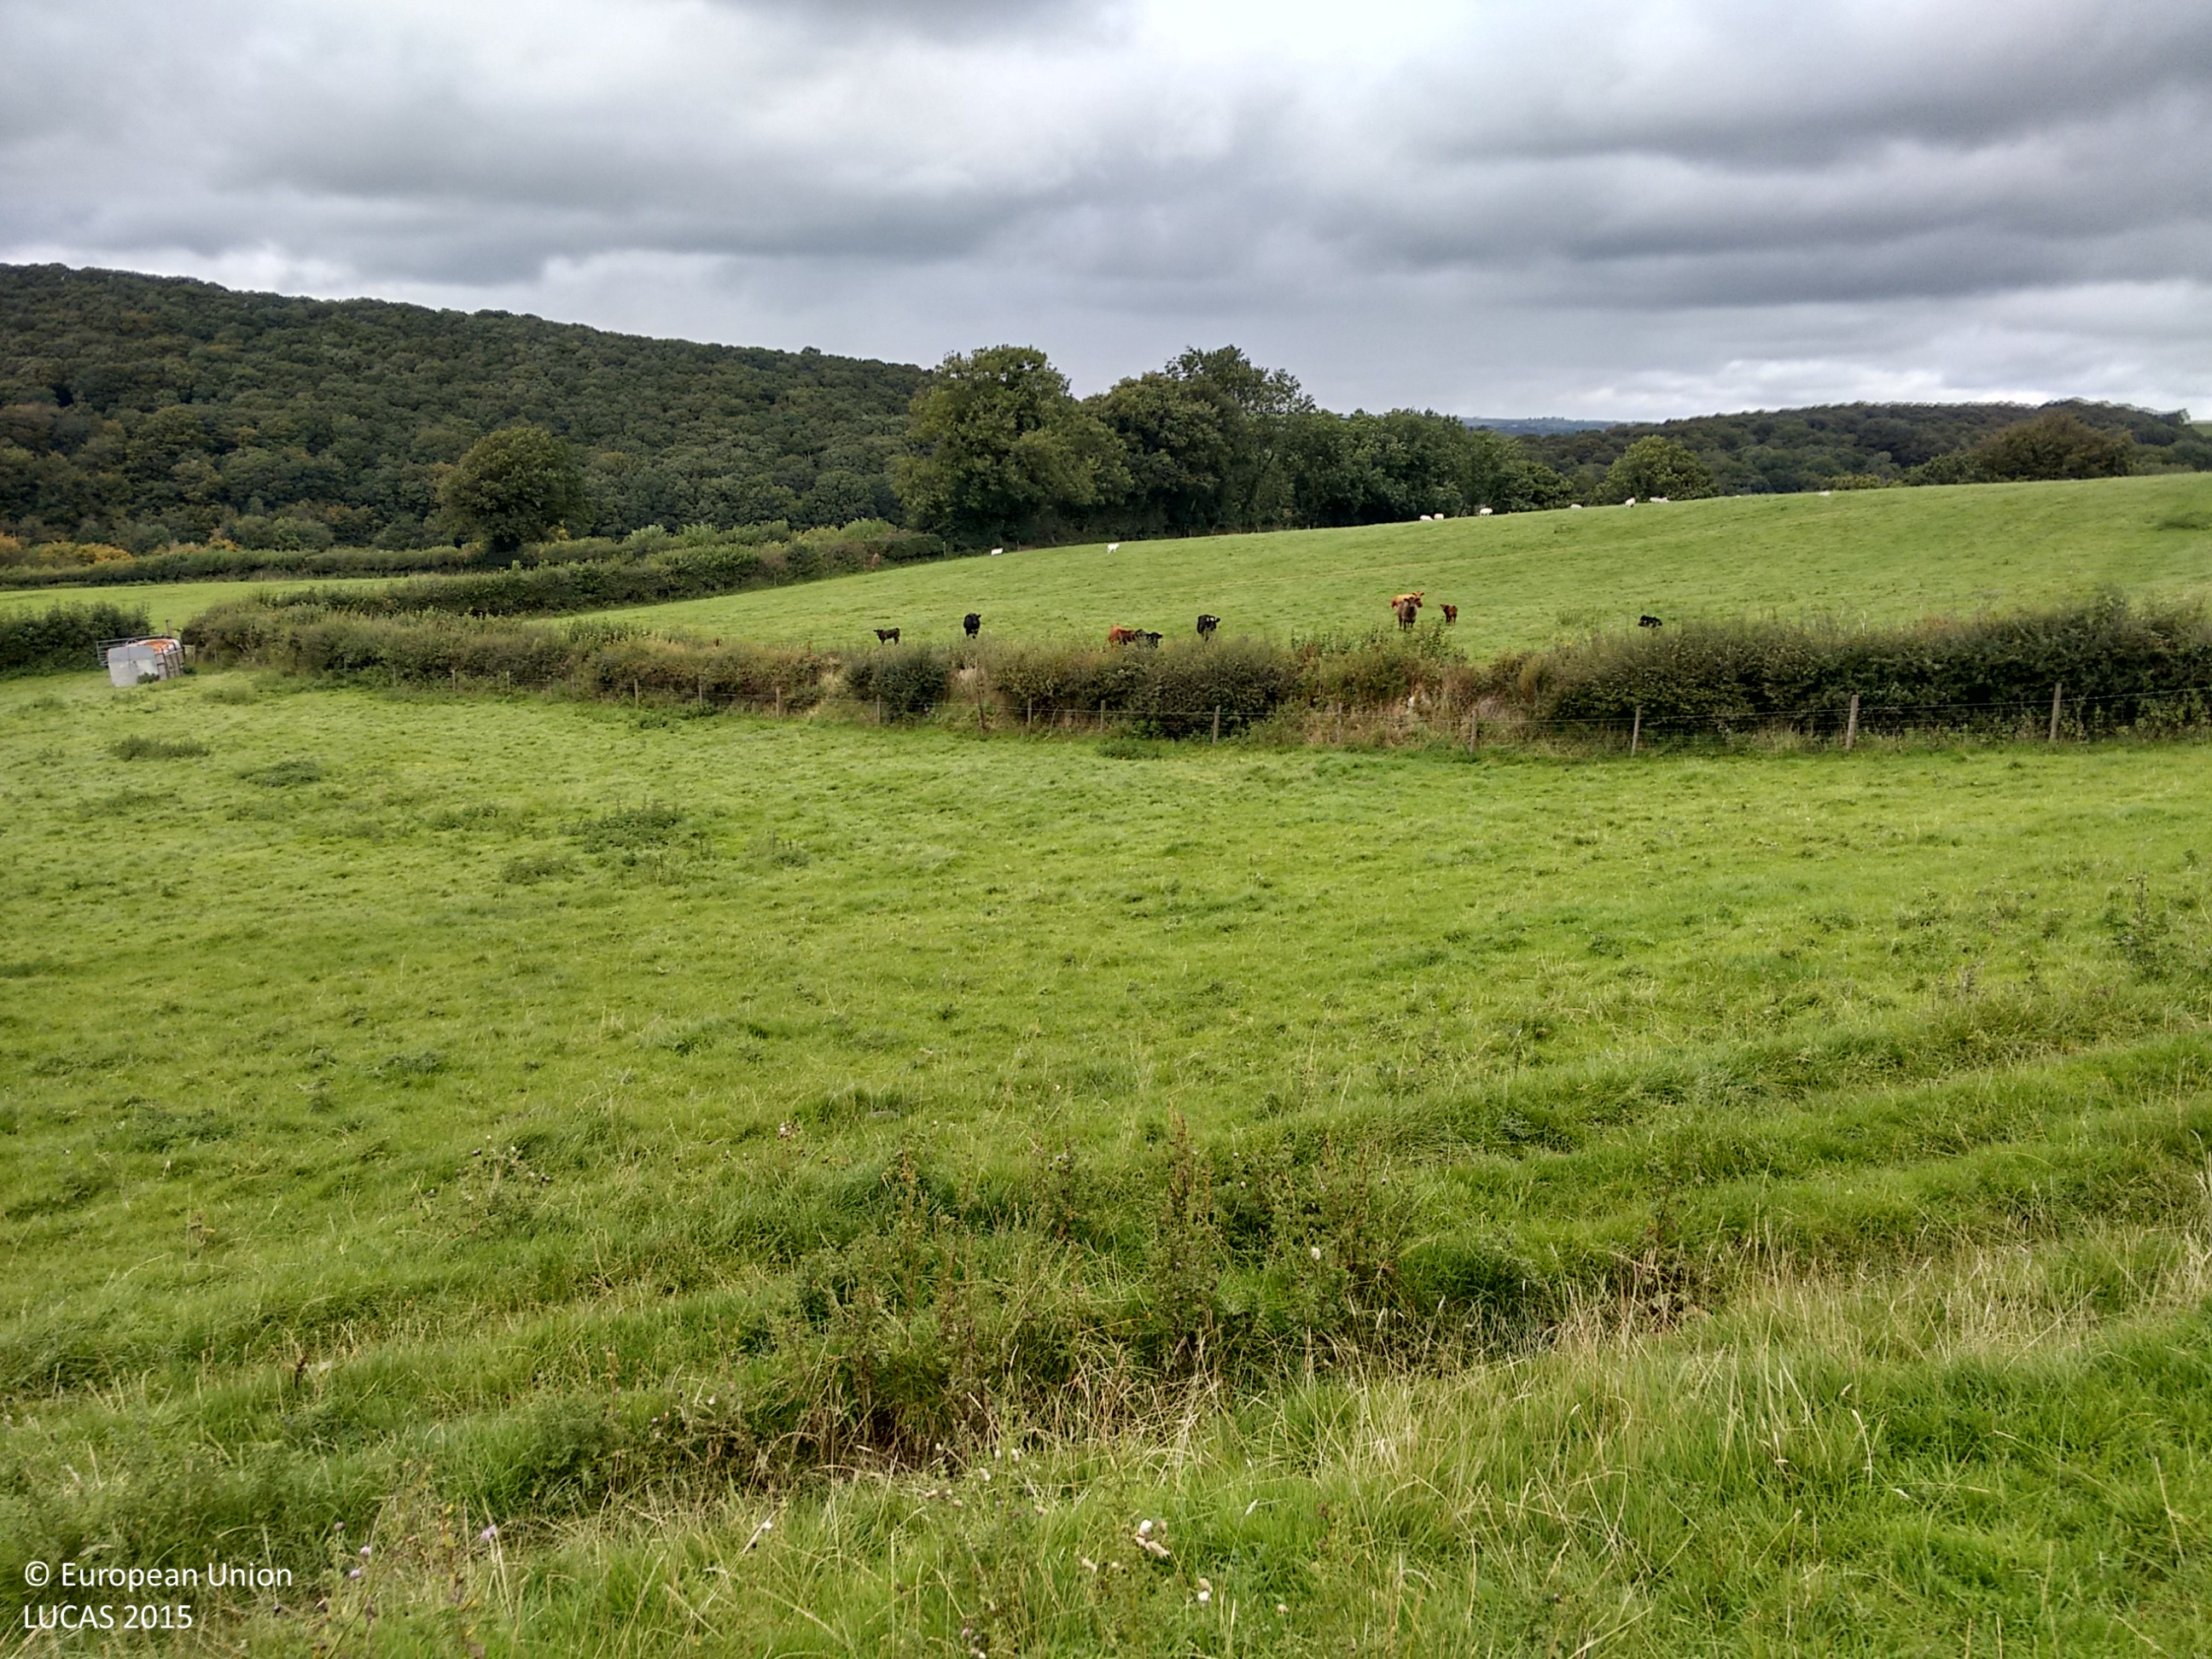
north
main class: Grassland
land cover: Grassland without tree/shrub cover
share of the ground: > 75 %
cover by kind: herbaceous plants 100 %
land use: Agriculture (excluding fallow land and kitchen gardens)
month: September
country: GB
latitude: 50.6661
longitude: -4.1460
